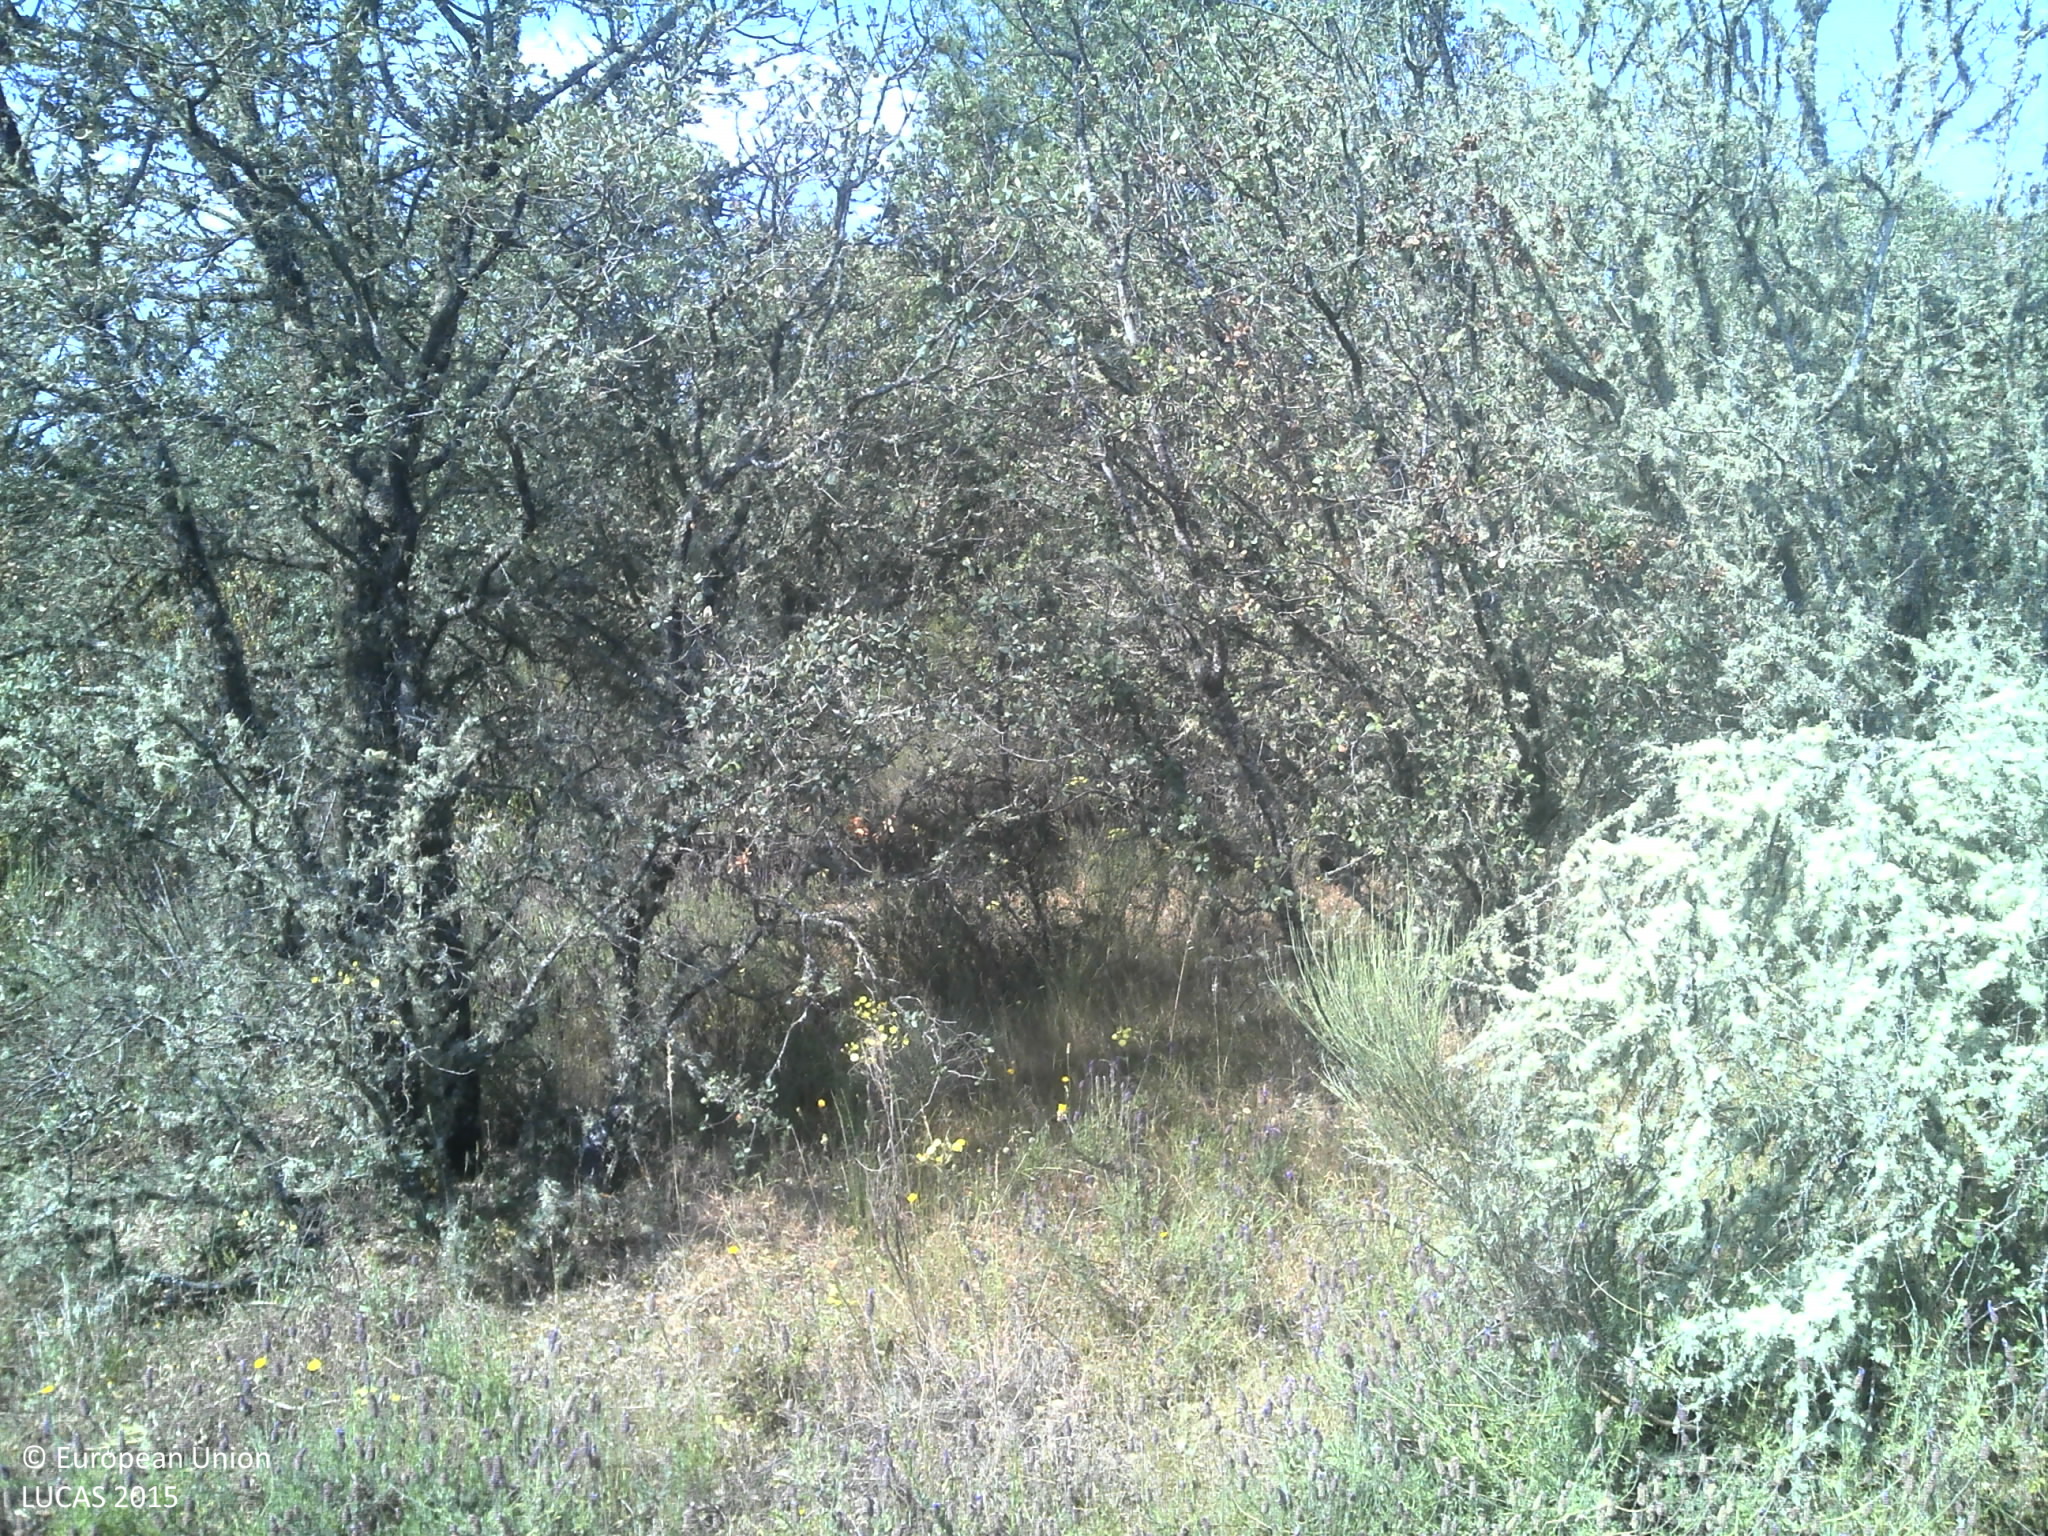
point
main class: Woodland
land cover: Broadleaved woodland
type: broadleaved evergreen forest
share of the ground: 50 - 75 %
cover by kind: broadleaved forest trees 70 %, herbaceous plants 15 %, shrubs 10 %, unconsolidated bare surface 5 %
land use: Forestry
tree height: > 5 m
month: June
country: PT
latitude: 40.4526
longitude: -6.8744
